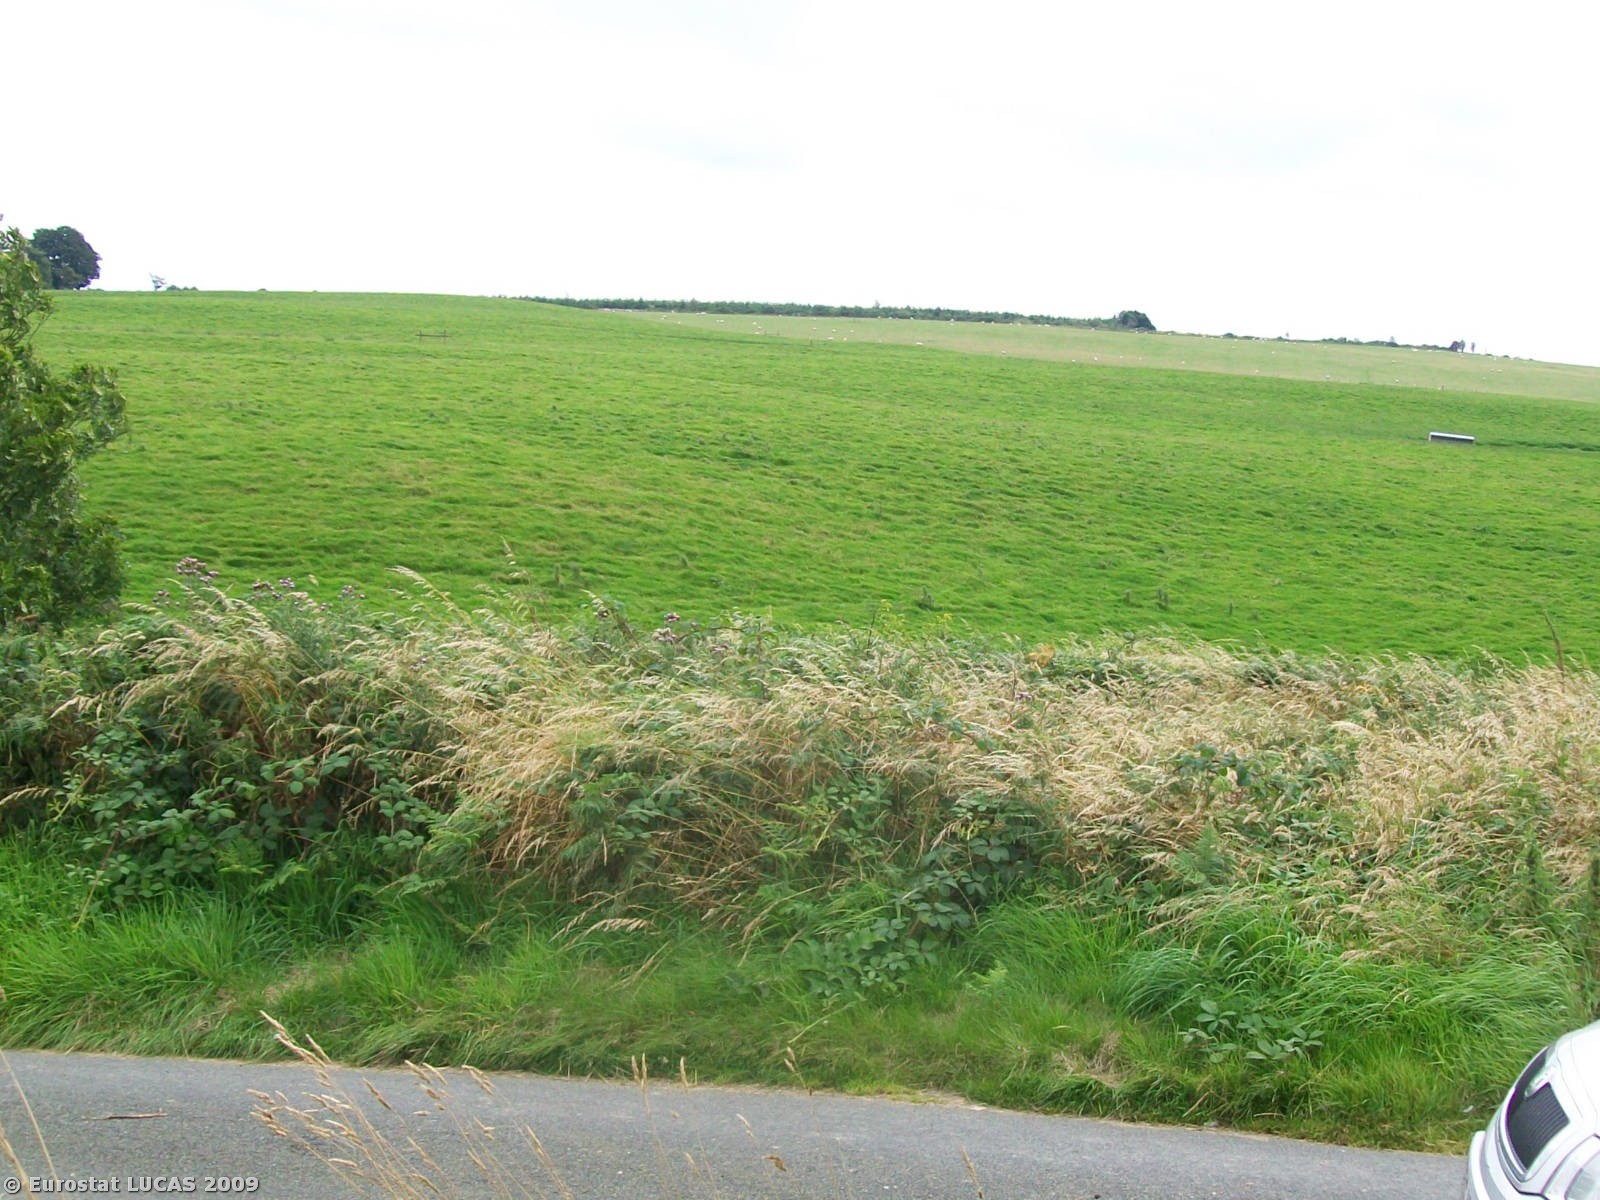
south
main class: Grassland
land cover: Grassland without tree/shrub cover
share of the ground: > 75 %
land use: Agriculture (excluding fallow land and kitchen gardens)
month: August
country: GB
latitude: 52.4992
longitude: -3.1436
